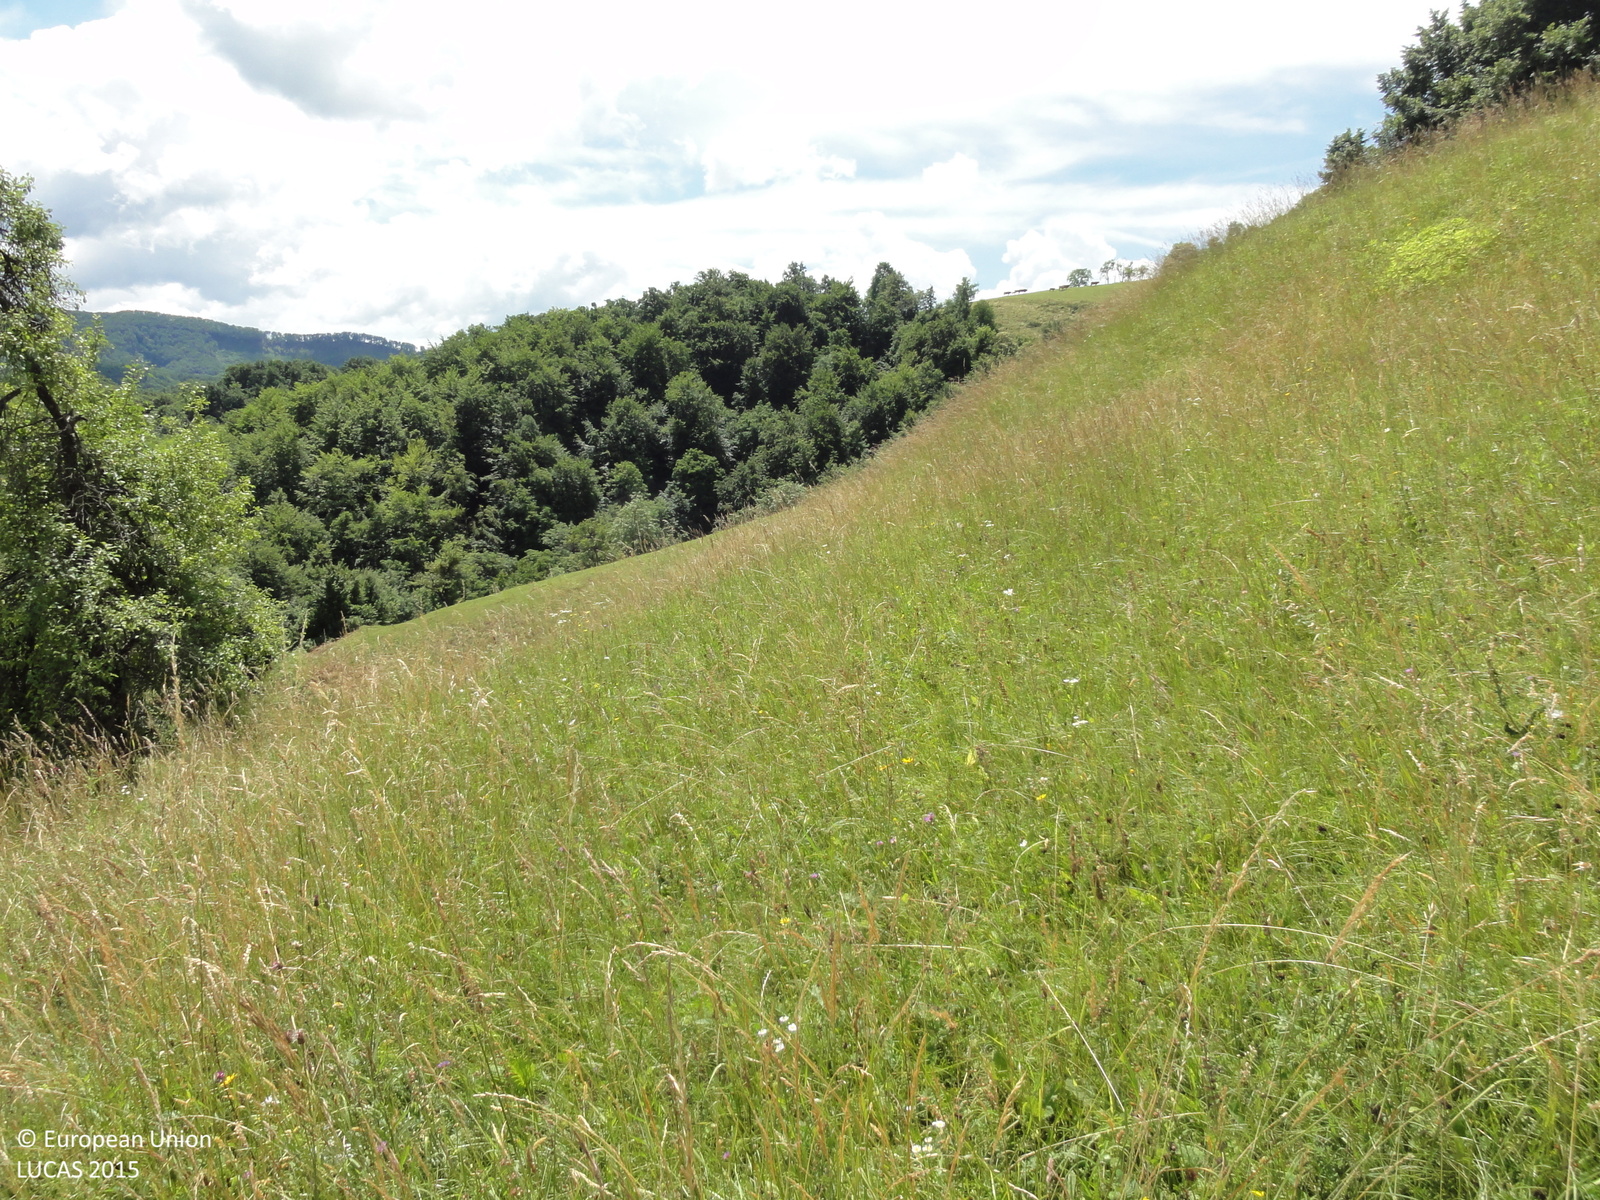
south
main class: Grassland
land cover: Grassland with sparse tree/shrub cover
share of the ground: > 75 %
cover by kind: herbaceous plants 95 %, broadleaved forest trees 5 %
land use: Agriculture (excluding fallow land and kitchen gardens)
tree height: > 5 m
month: June
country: SI
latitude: 46.2897
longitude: 15.6969
